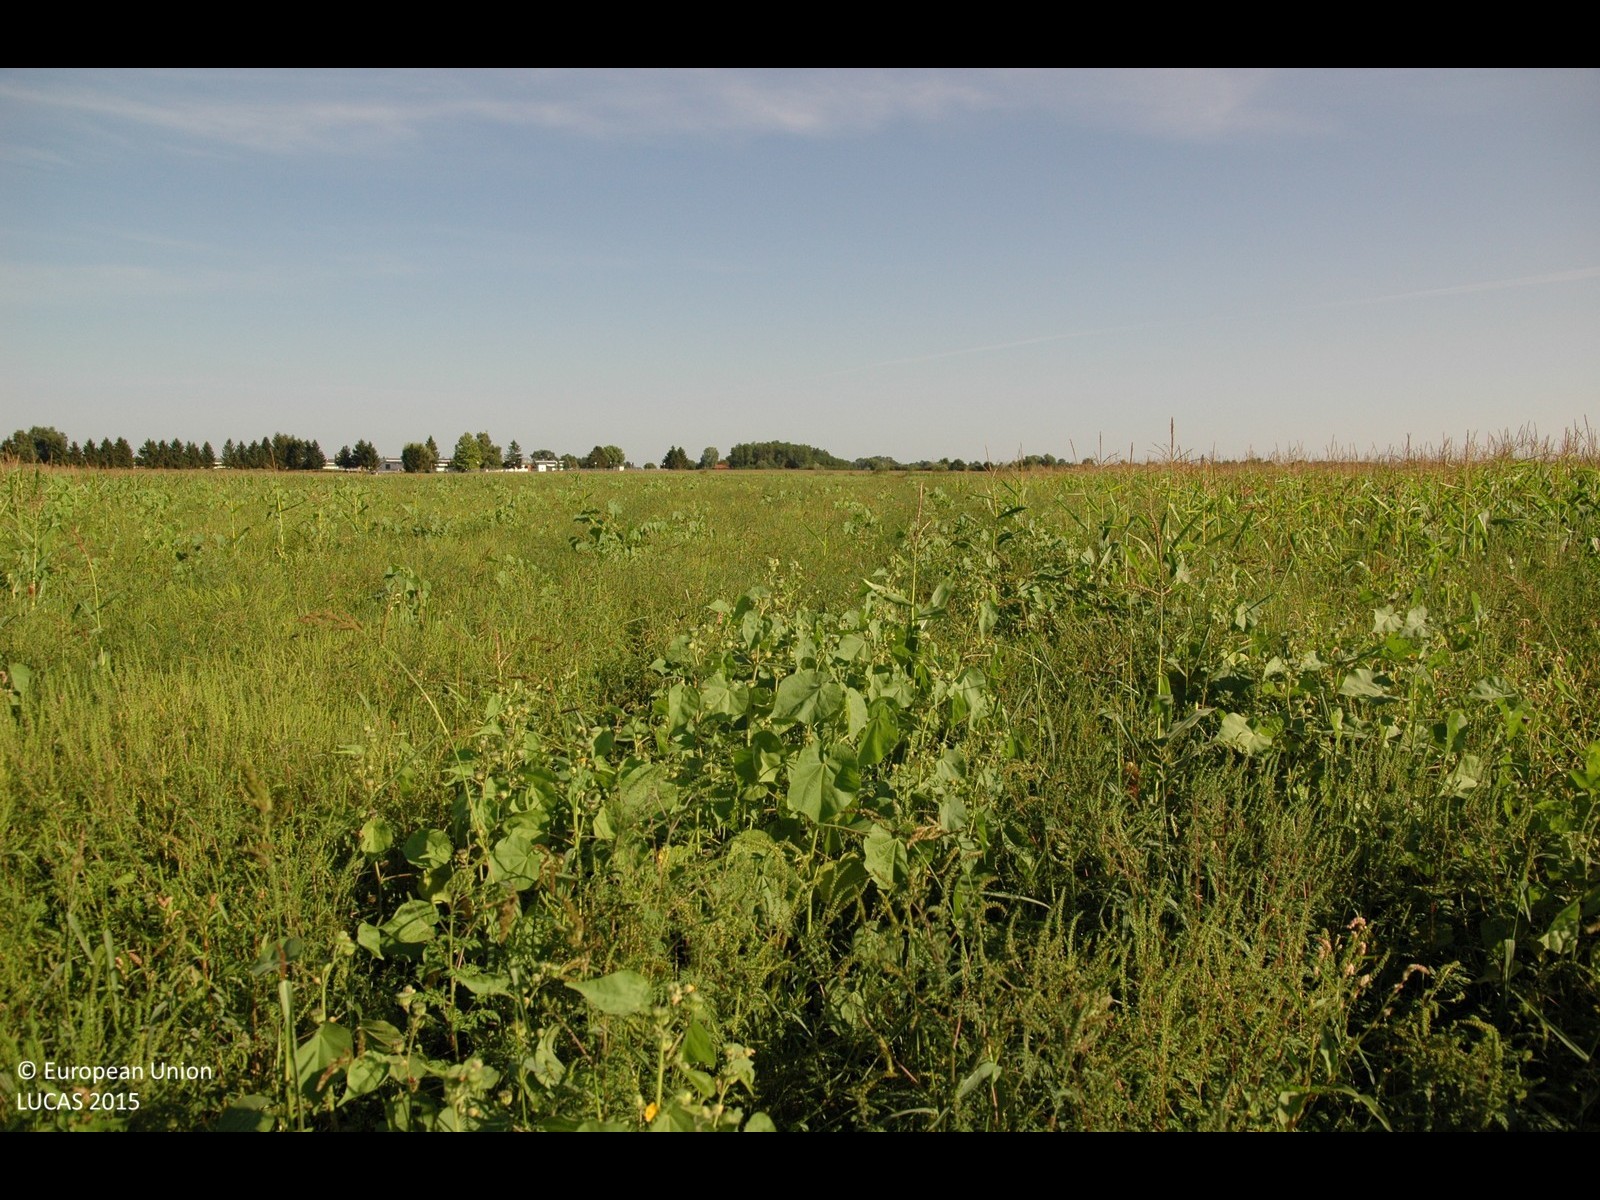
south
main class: Grassland
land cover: Spontaneously vegetated surfaces
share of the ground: > 75 %
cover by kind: herbaceous plants 100 %
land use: Fallow land
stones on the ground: < 10 %
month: August
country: HR
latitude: 46.1250
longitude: 16.9512
